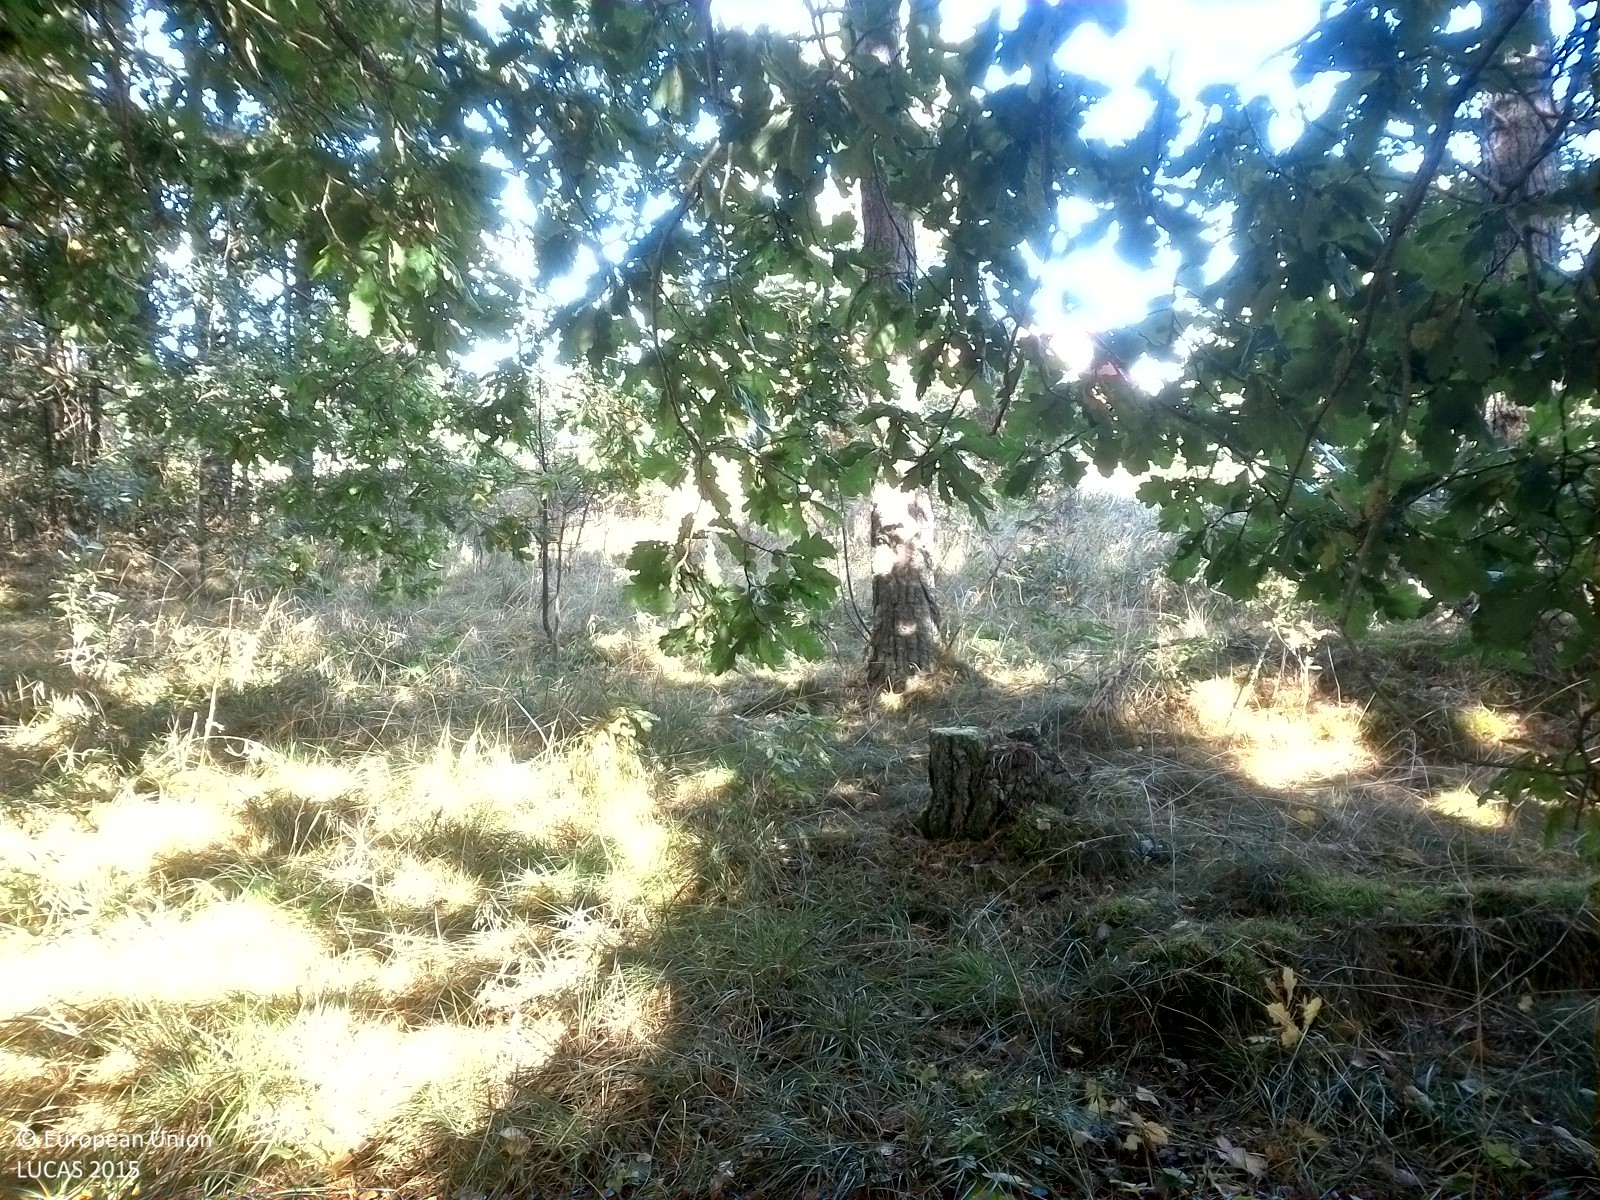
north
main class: Woodland
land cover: Pine dominated mixed woodland
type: boreal forest
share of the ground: 25 - 50 %
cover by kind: herbaceous plants 45 %, coniferous forest trees 25 %, broadleaved forest trees 20 %, shrubs 5 %, lichens and mosses 5 %
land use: Forestry
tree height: > 5 m
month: September
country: SE
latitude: 58.4932
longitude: 16.9112
